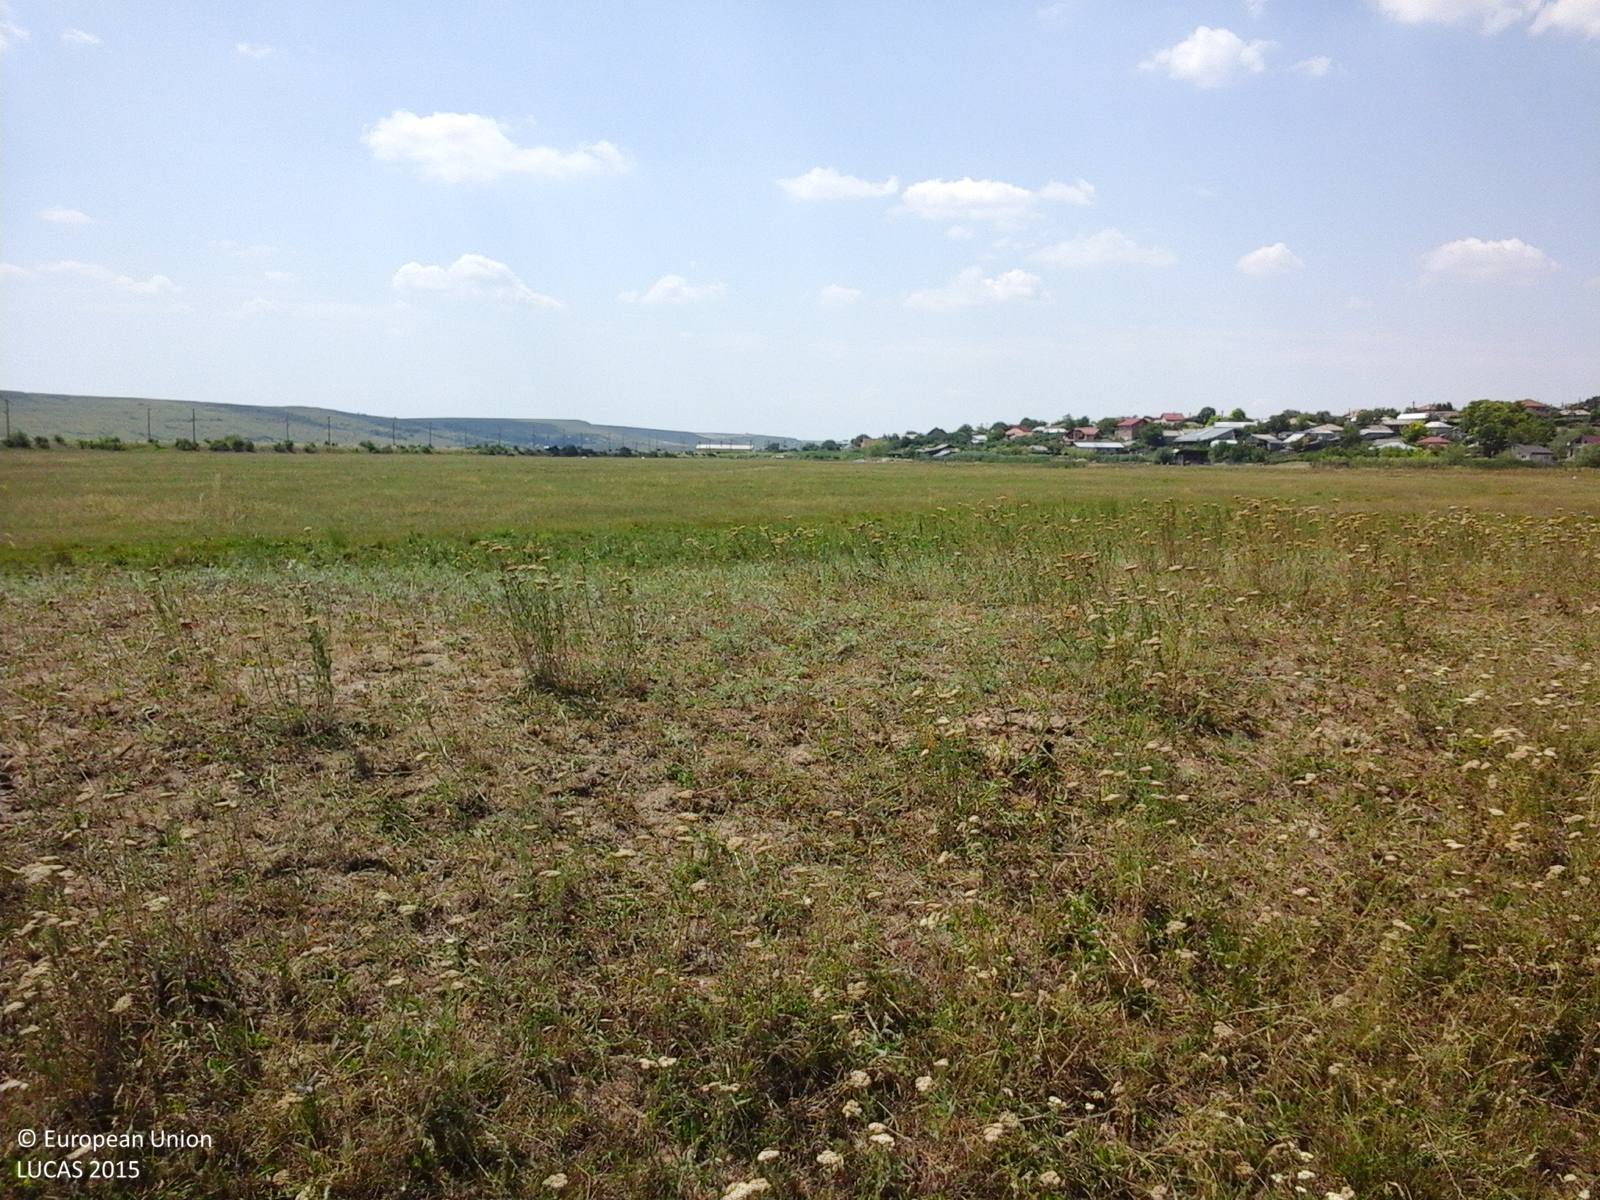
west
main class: Grassland
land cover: Grassland without tree/shrub cover
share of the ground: > 75 %
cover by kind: herbaceous plants 100 %
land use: Agriculture (excluding fallow land and kitchen gardens)
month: June
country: RO
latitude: 47.1908
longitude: 27.4162
